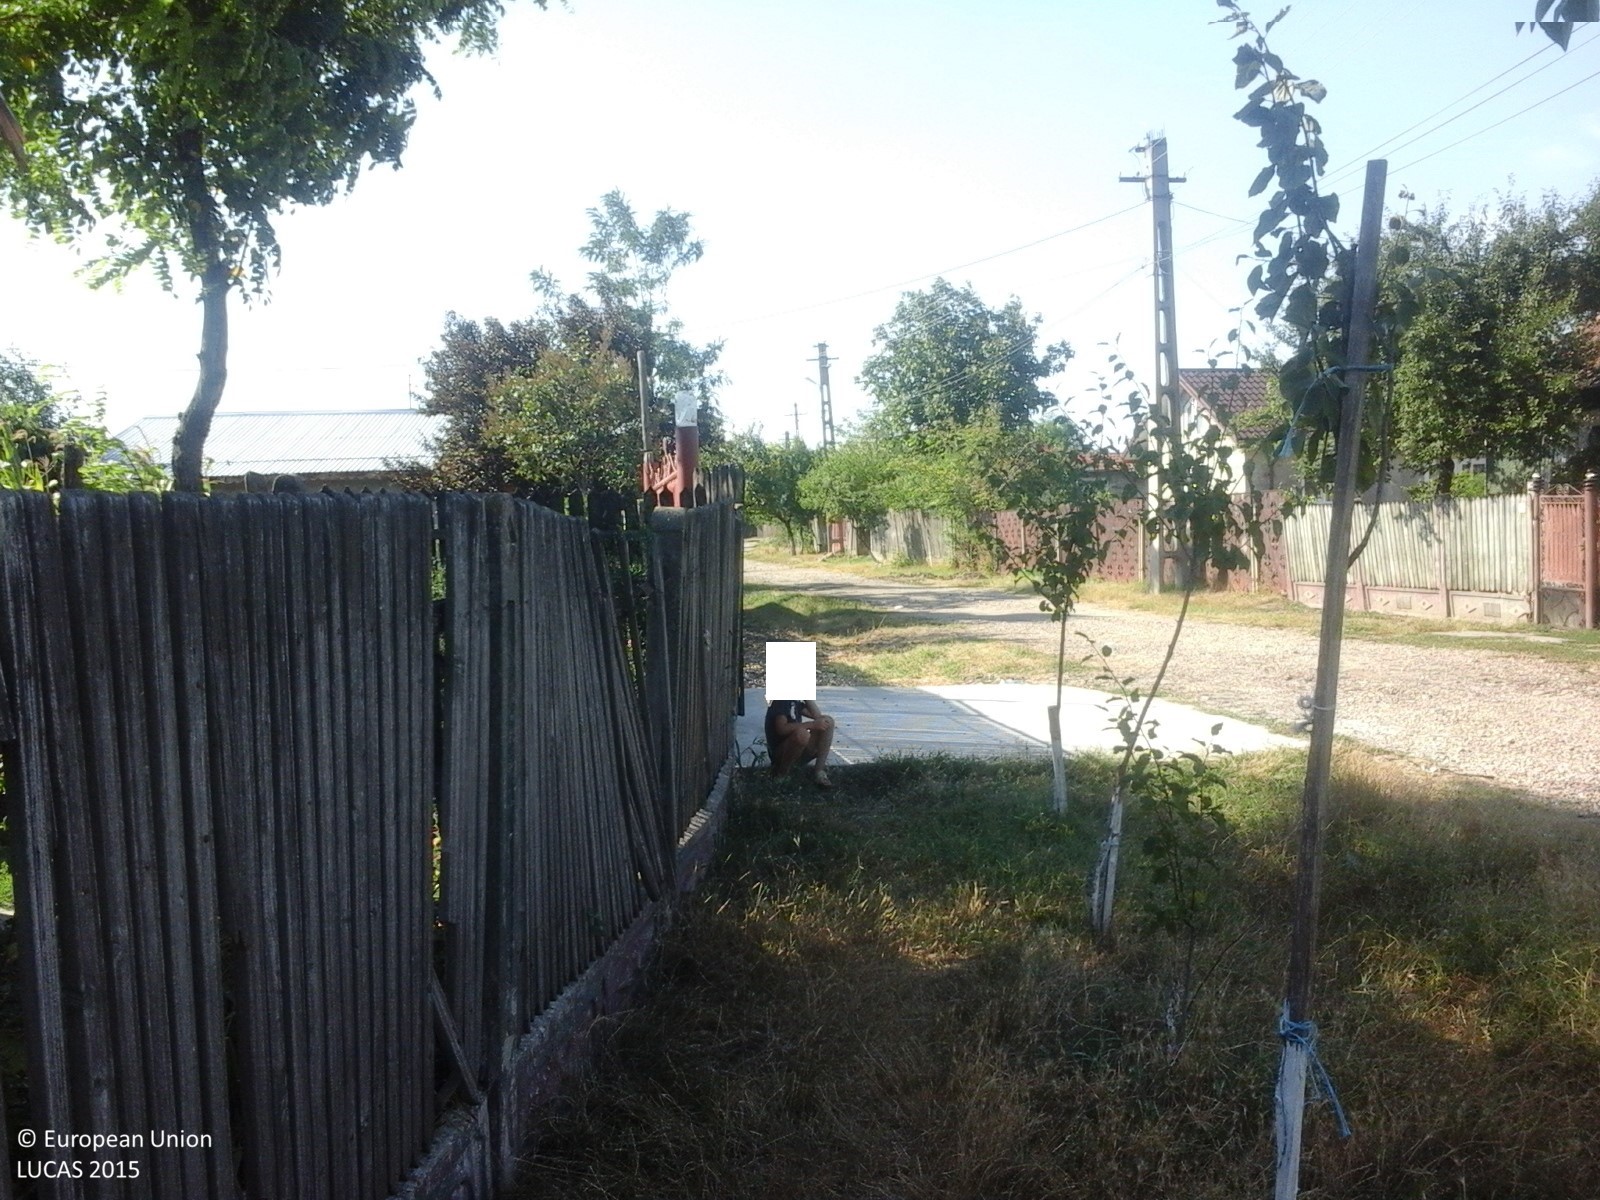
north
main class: Grassland
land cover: Grassland with sparse tree/shrub cover
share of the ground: > 75 %
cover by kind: herbaceous plants 90 %, broadleaved forest trees 5 %, shrubs 5 %
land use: Agriculture (excluding fallow land and kitchen gardens)
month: August
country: RO
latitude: 45.0807
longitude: 26.7053
